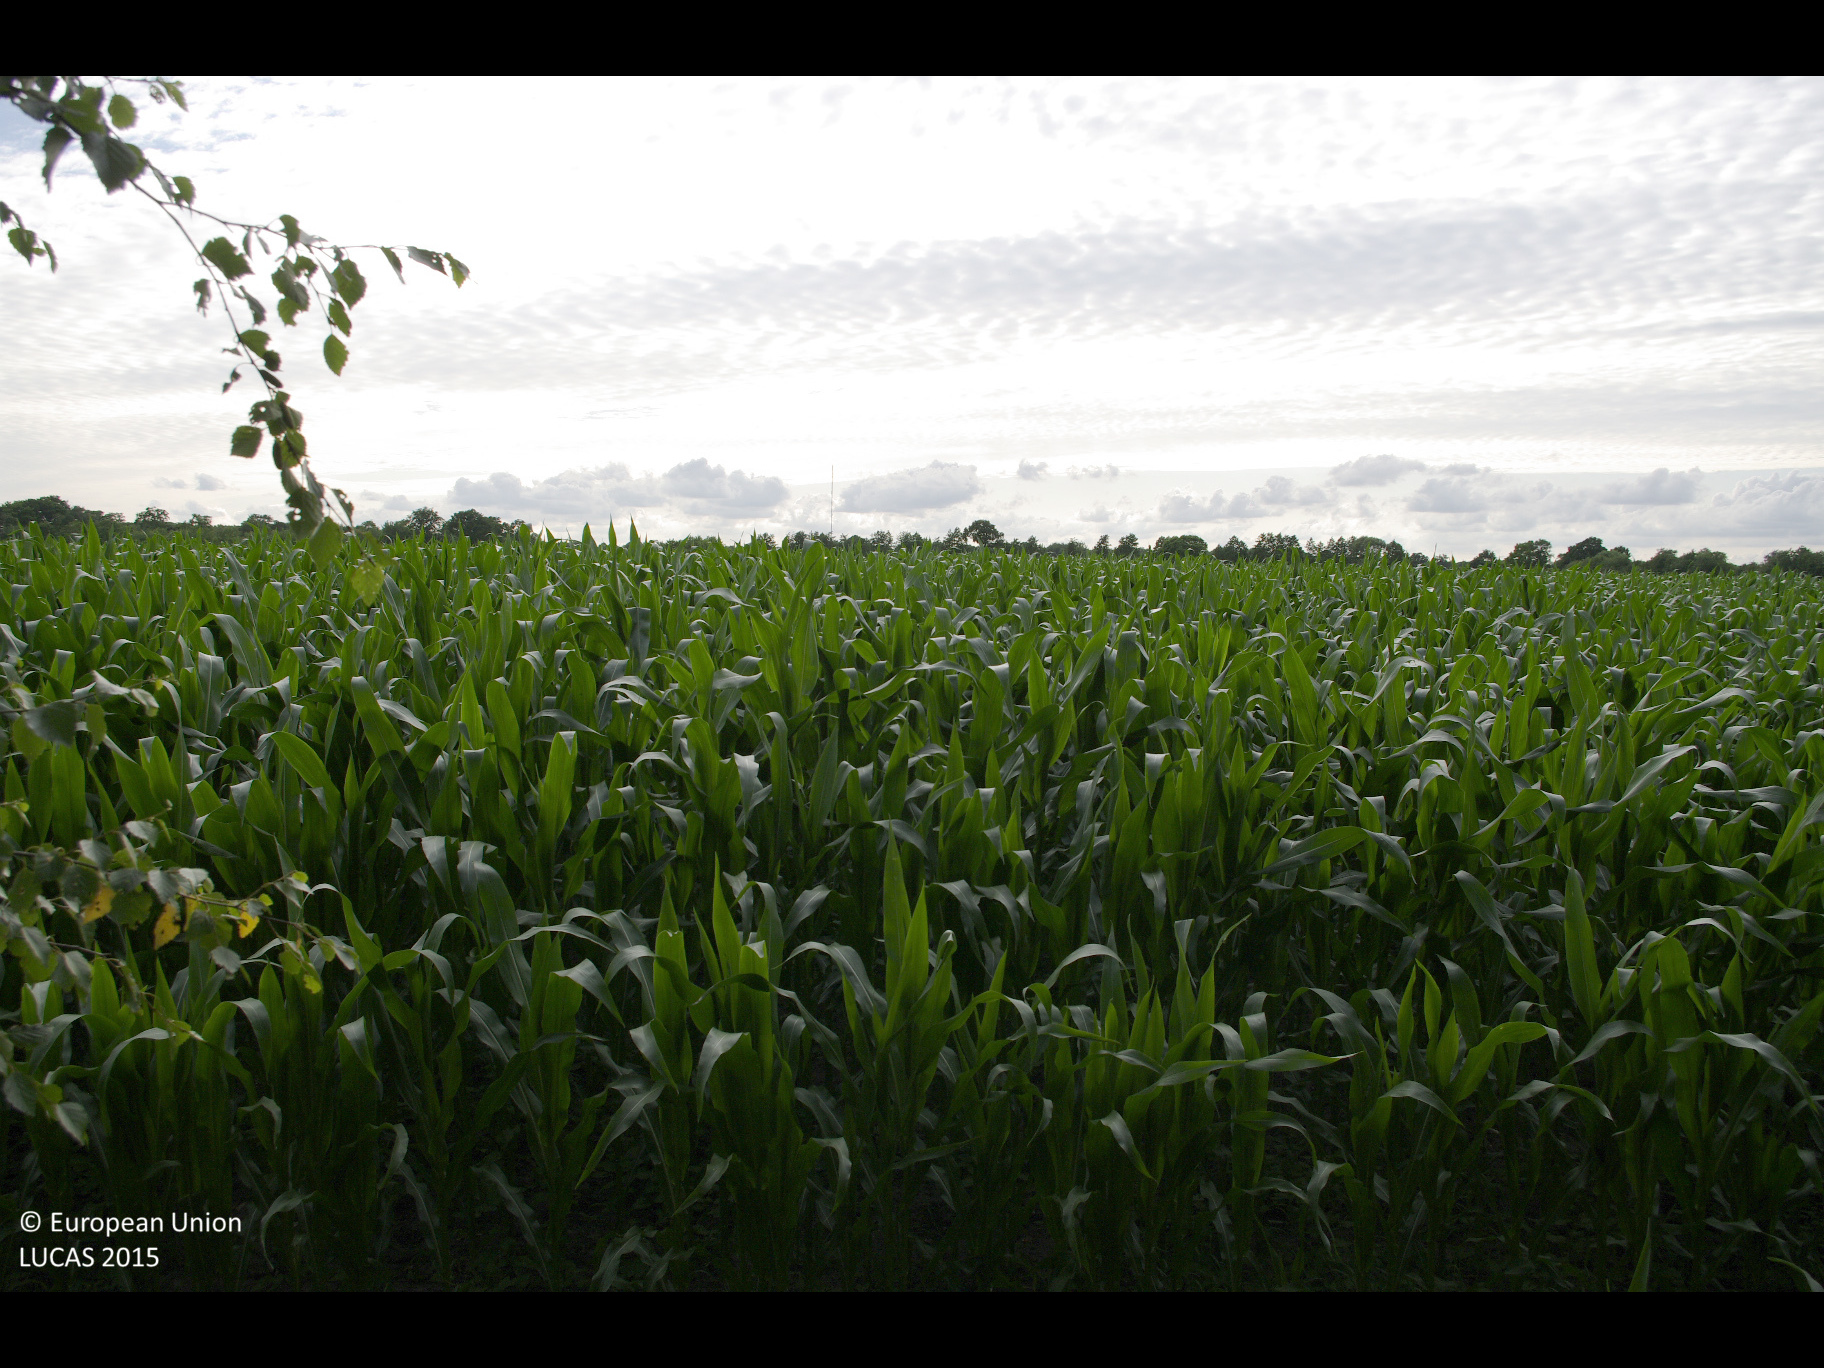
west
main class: Cropland
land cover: Maize
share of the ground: > 75 %
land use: Agriculture (excluding fallow land and kitchen gardens)
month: July
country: DE
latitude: 53.9770
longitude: 9.8933
